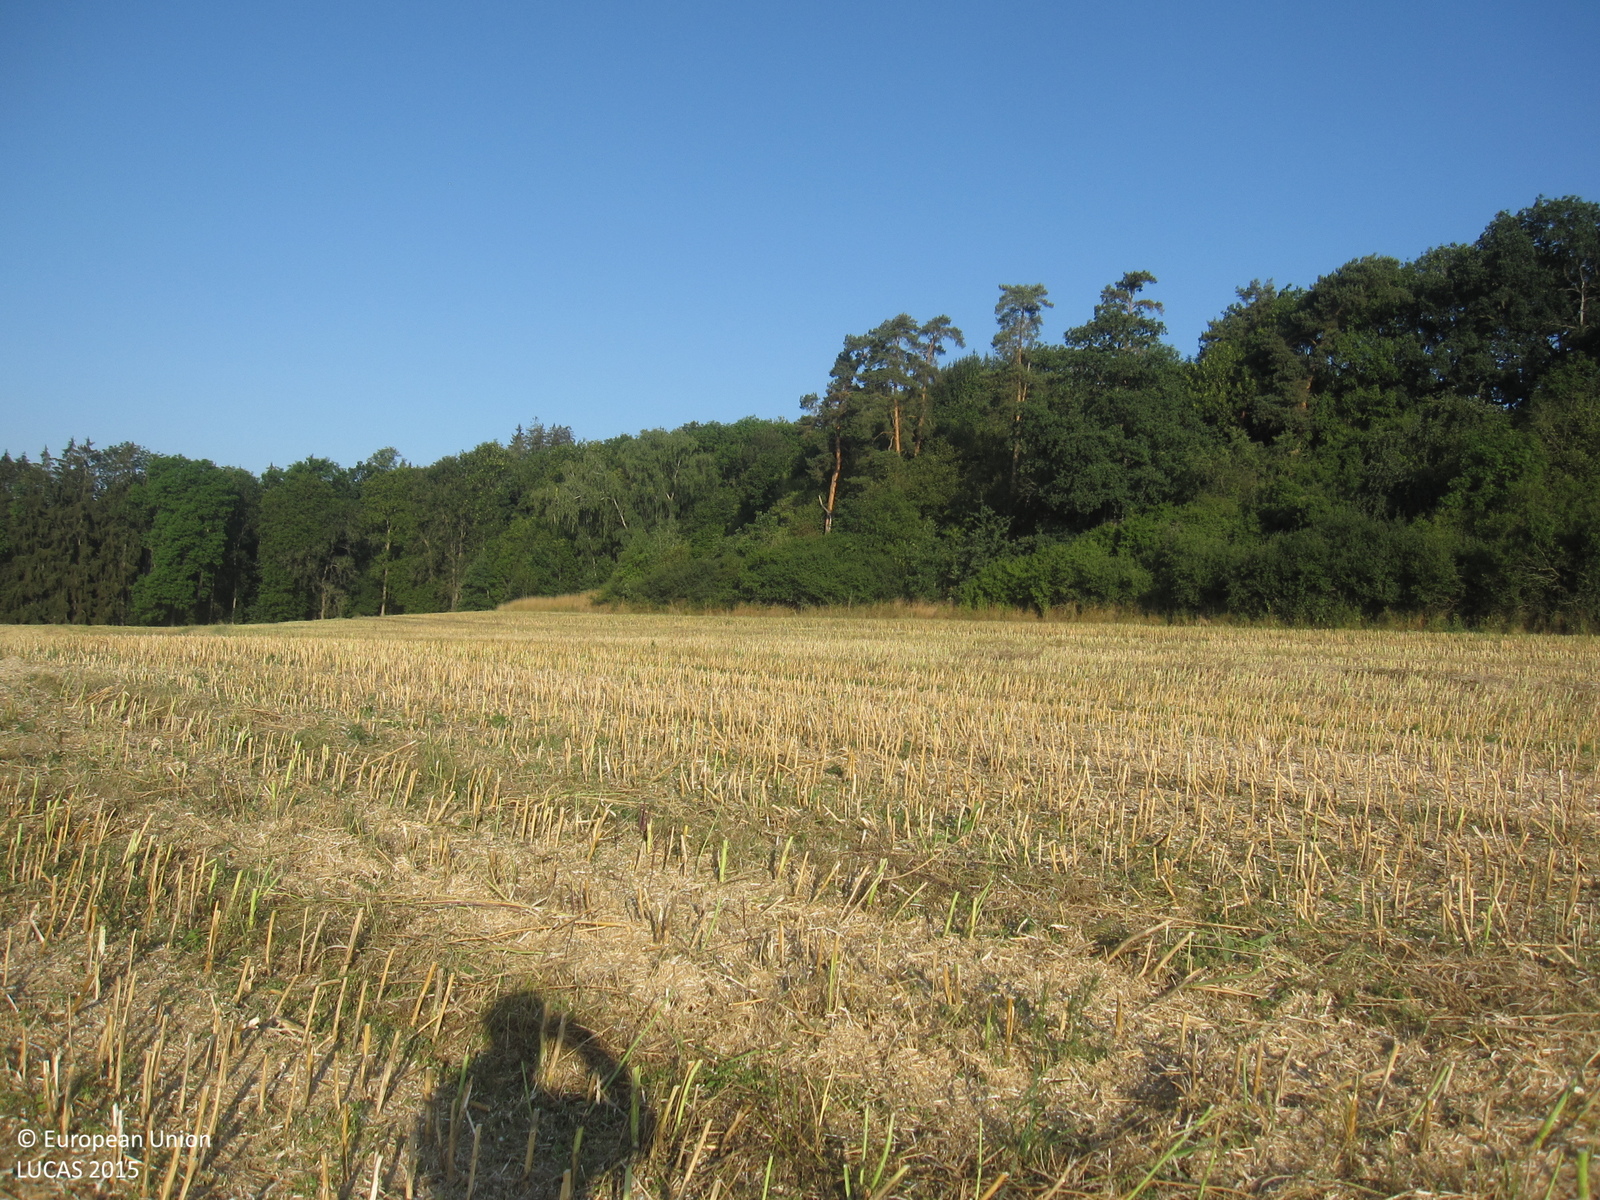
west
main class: Cropland
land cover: Rape and turnip rape
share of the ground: < 10 %
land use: Agriculture (excluding fallow land and kitchen gardens)
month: July
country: DE
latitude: 50.4178
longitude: 12.0403
